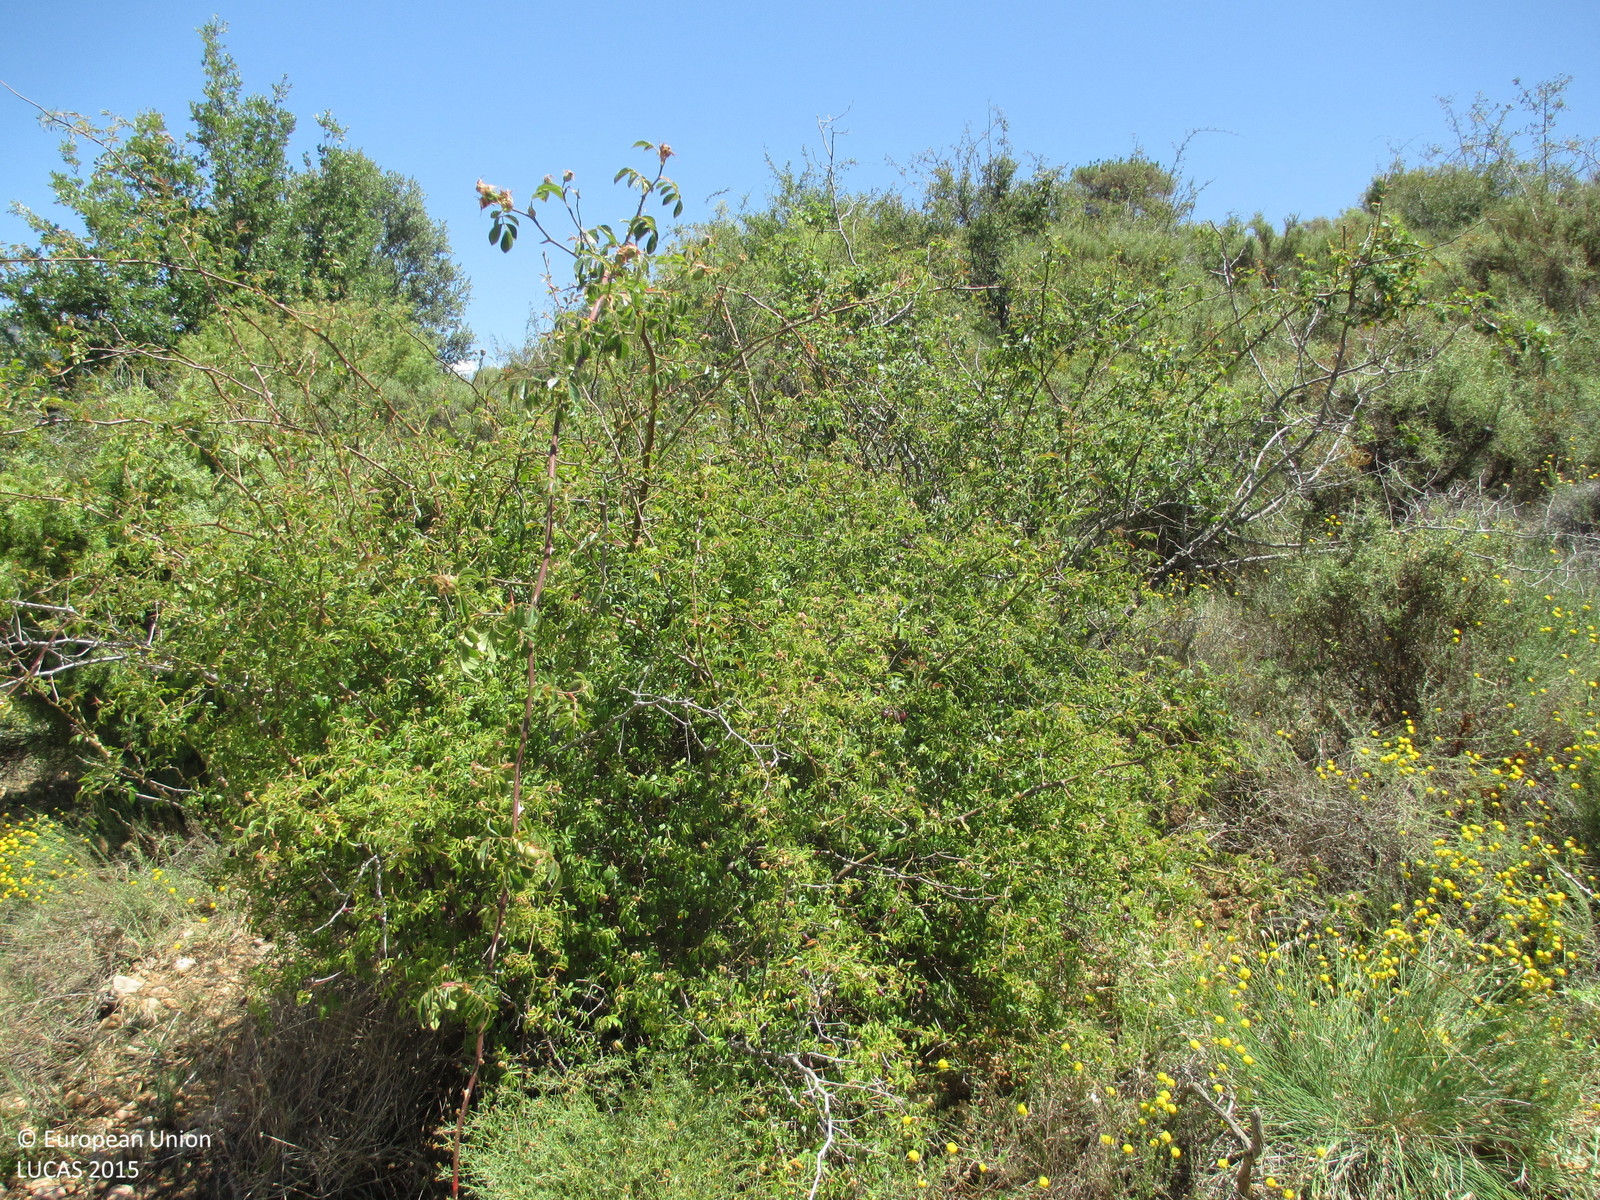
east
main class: Shrubland
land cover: Shrubland with sparse tree cover
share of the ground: > 75 %
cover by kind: shrubs 90 %, broadleaved forest trees 5 %, herbaceous plants 5 %
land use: Semi-natural and natural areas not in use
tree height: < 5 m
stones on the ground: < 10 %
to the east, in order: Shrubland with sparse tree cover; Barley
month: June
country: ES
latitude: 42.2307
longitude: -0.3585
